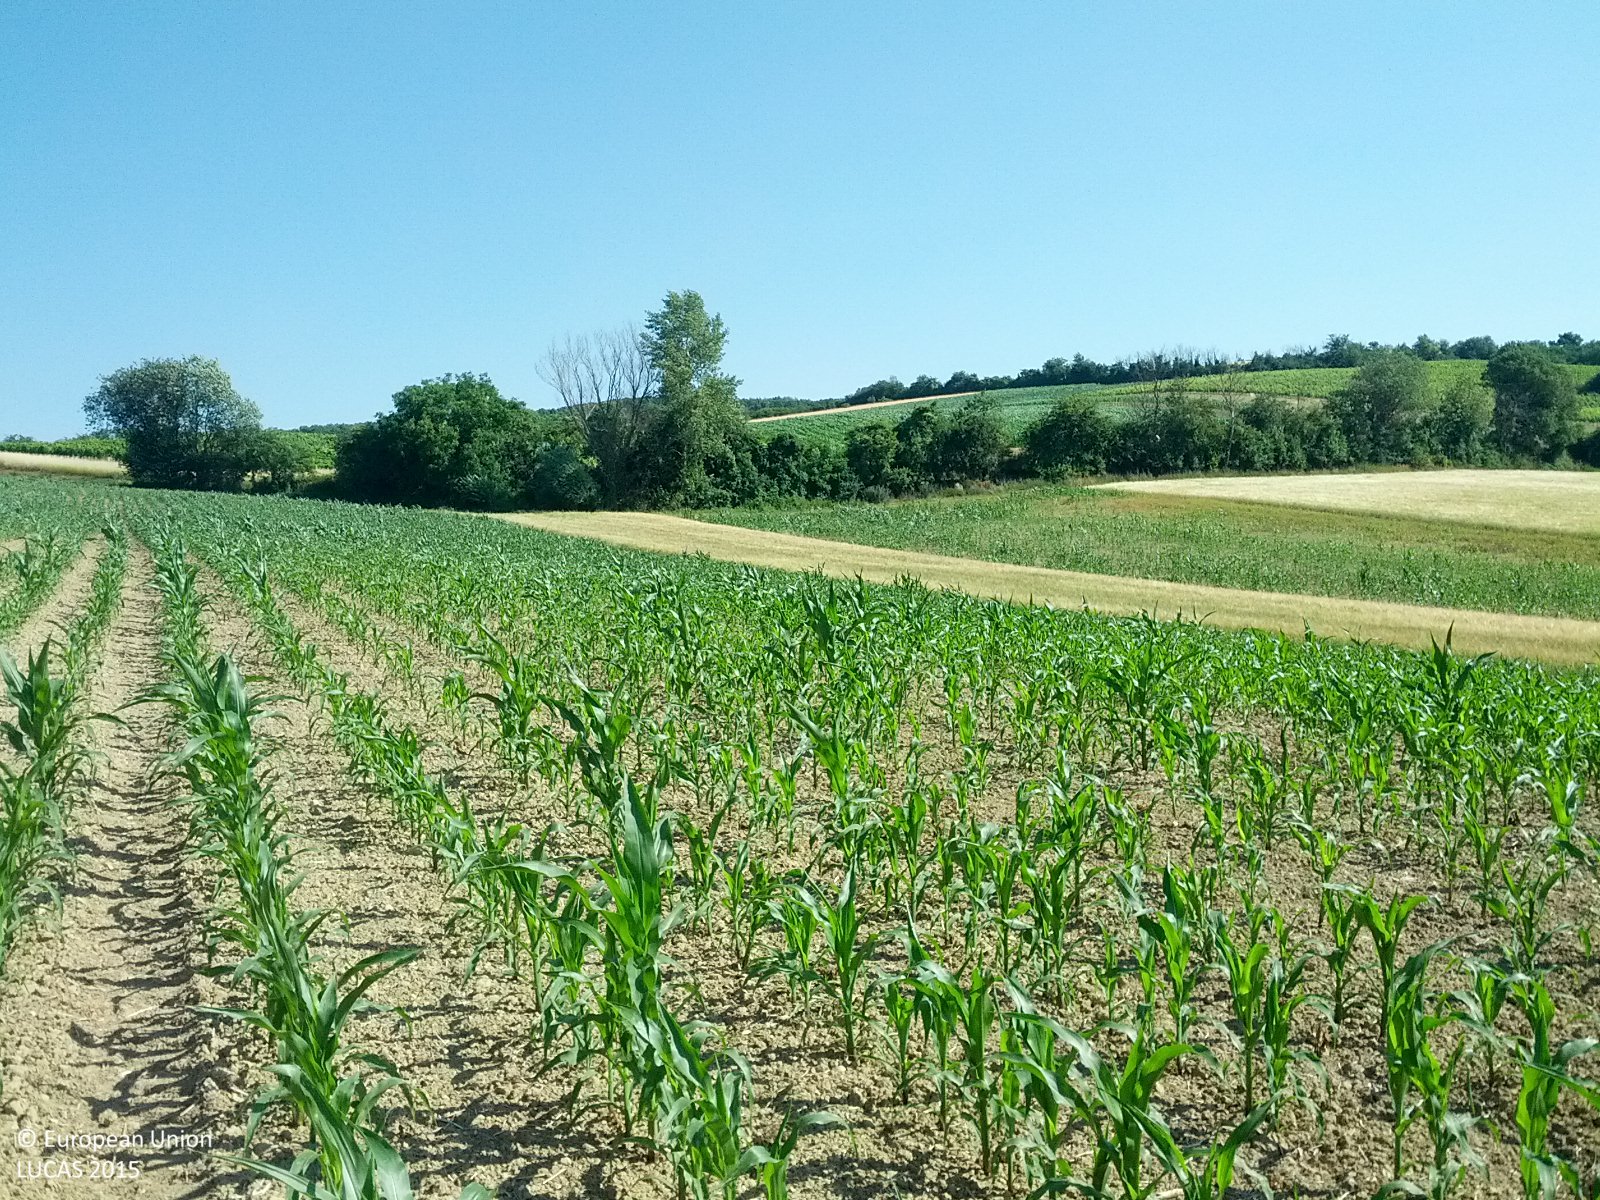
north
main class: Cropland
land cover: Maize
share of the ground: 10 - 25 %
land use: Agriculture (excluding fallow land and kitchen gardens)
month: July
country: AT
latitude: 48.6776
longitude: 16.5663
